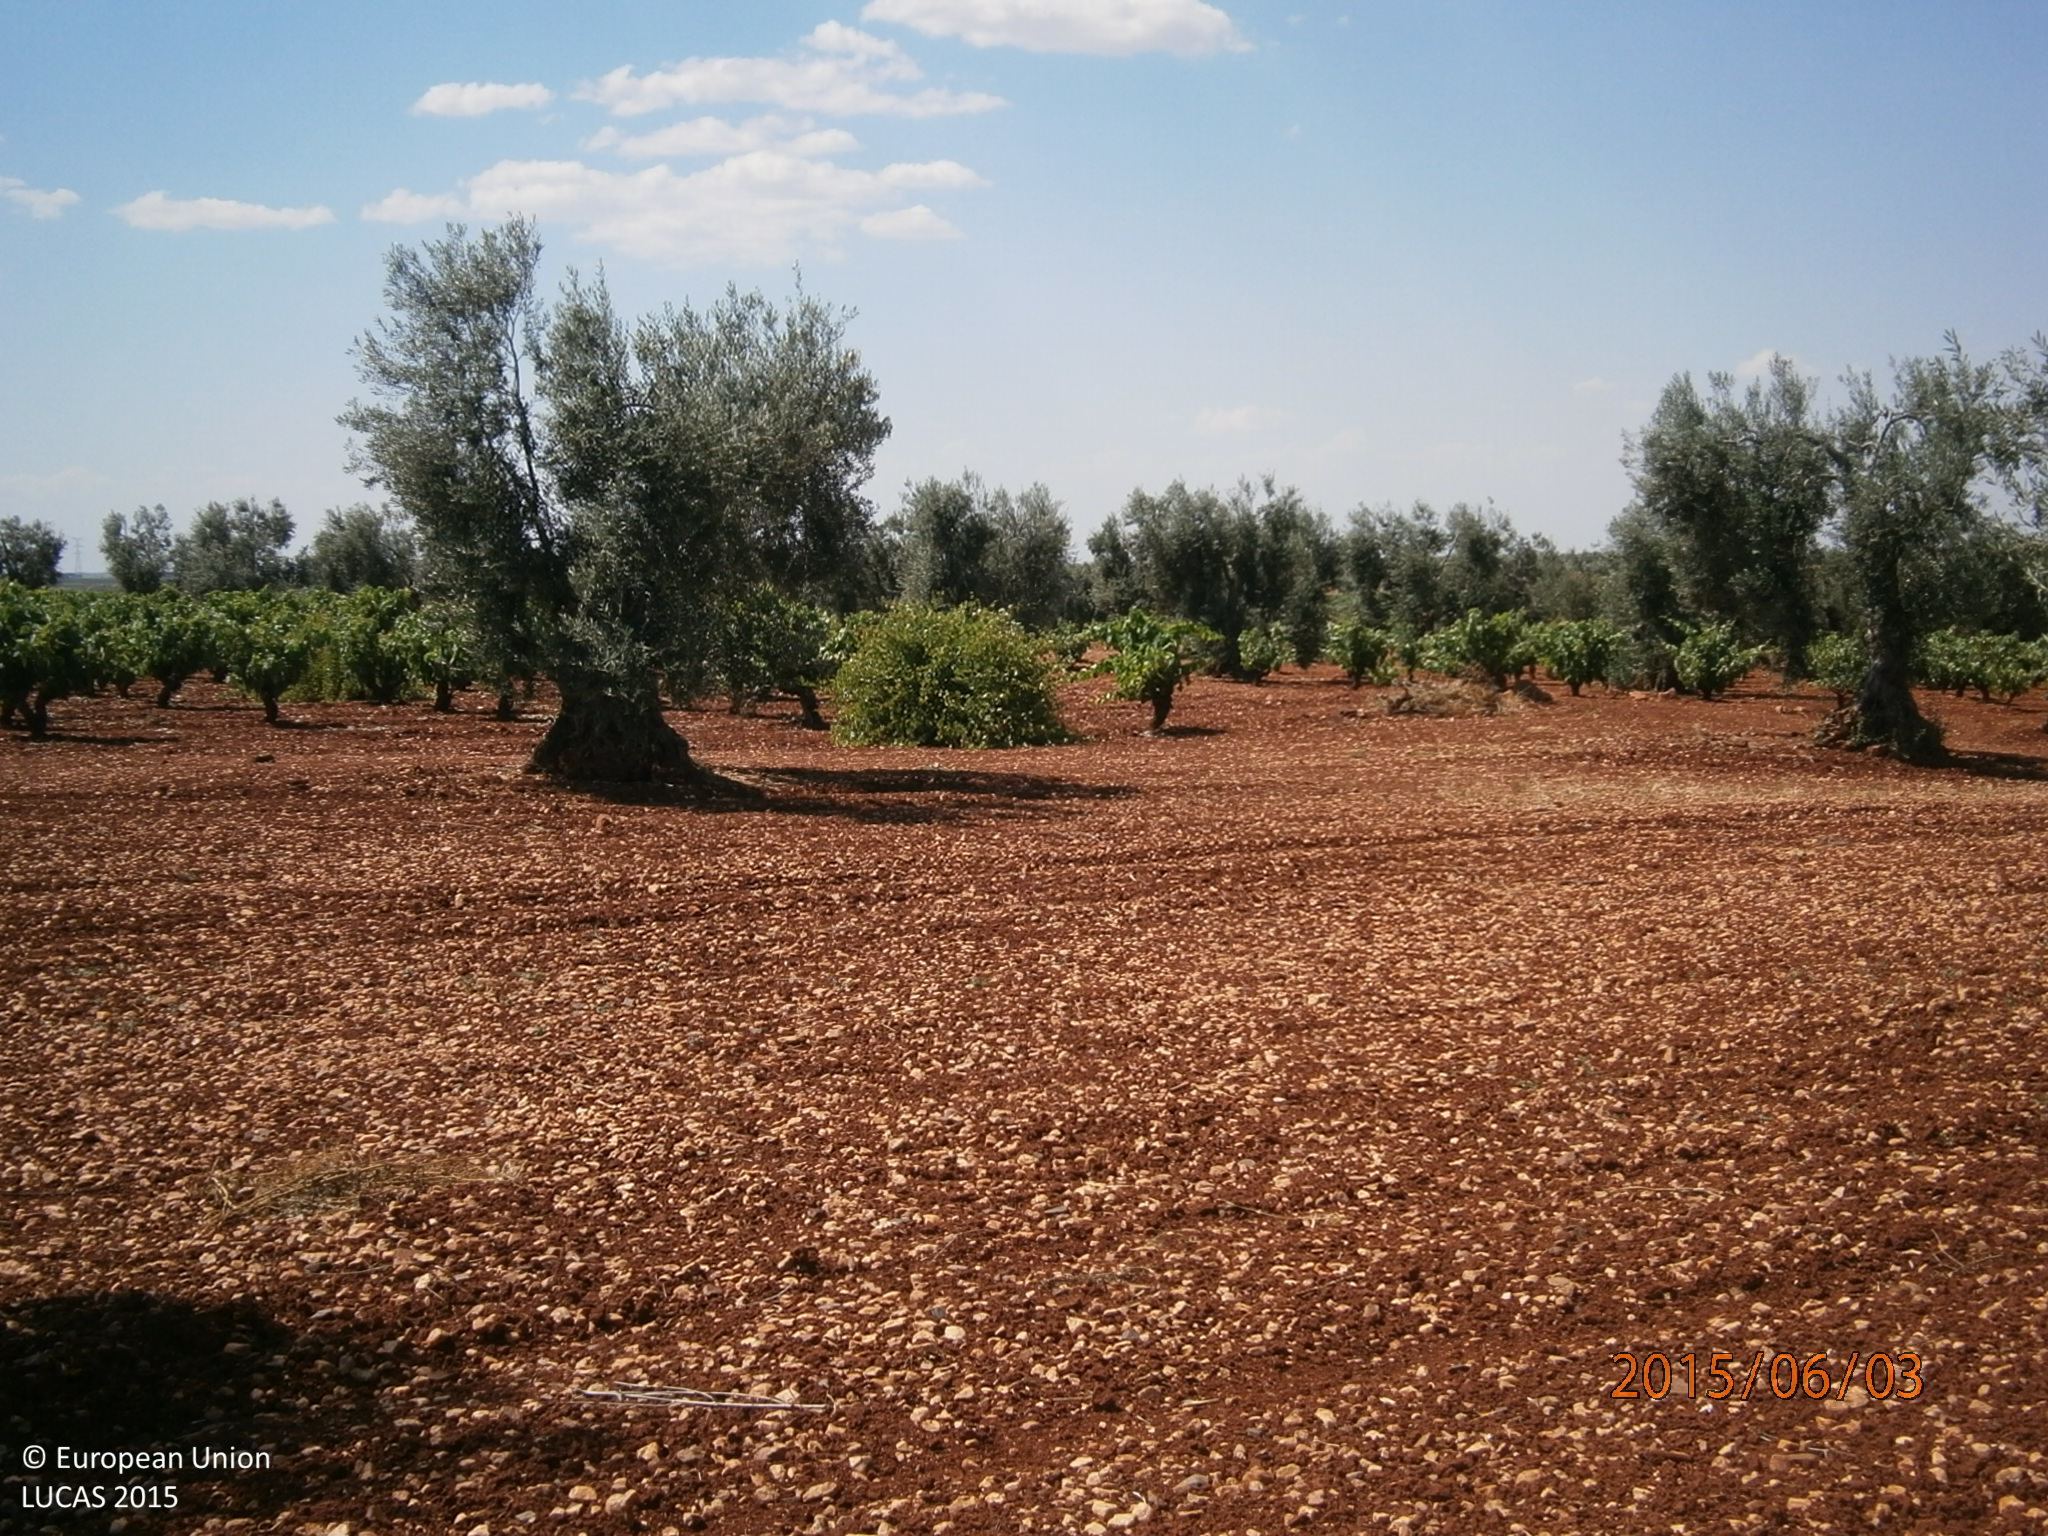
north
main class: Cropland
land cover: Olive groves
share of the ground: 10 - 25 %
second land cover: Other bare soil
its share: > 75 %
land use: Agriculture (excluding fallow land and kitchen gardens)
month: June
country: ES
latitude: 38.6330
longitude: -6.4240
